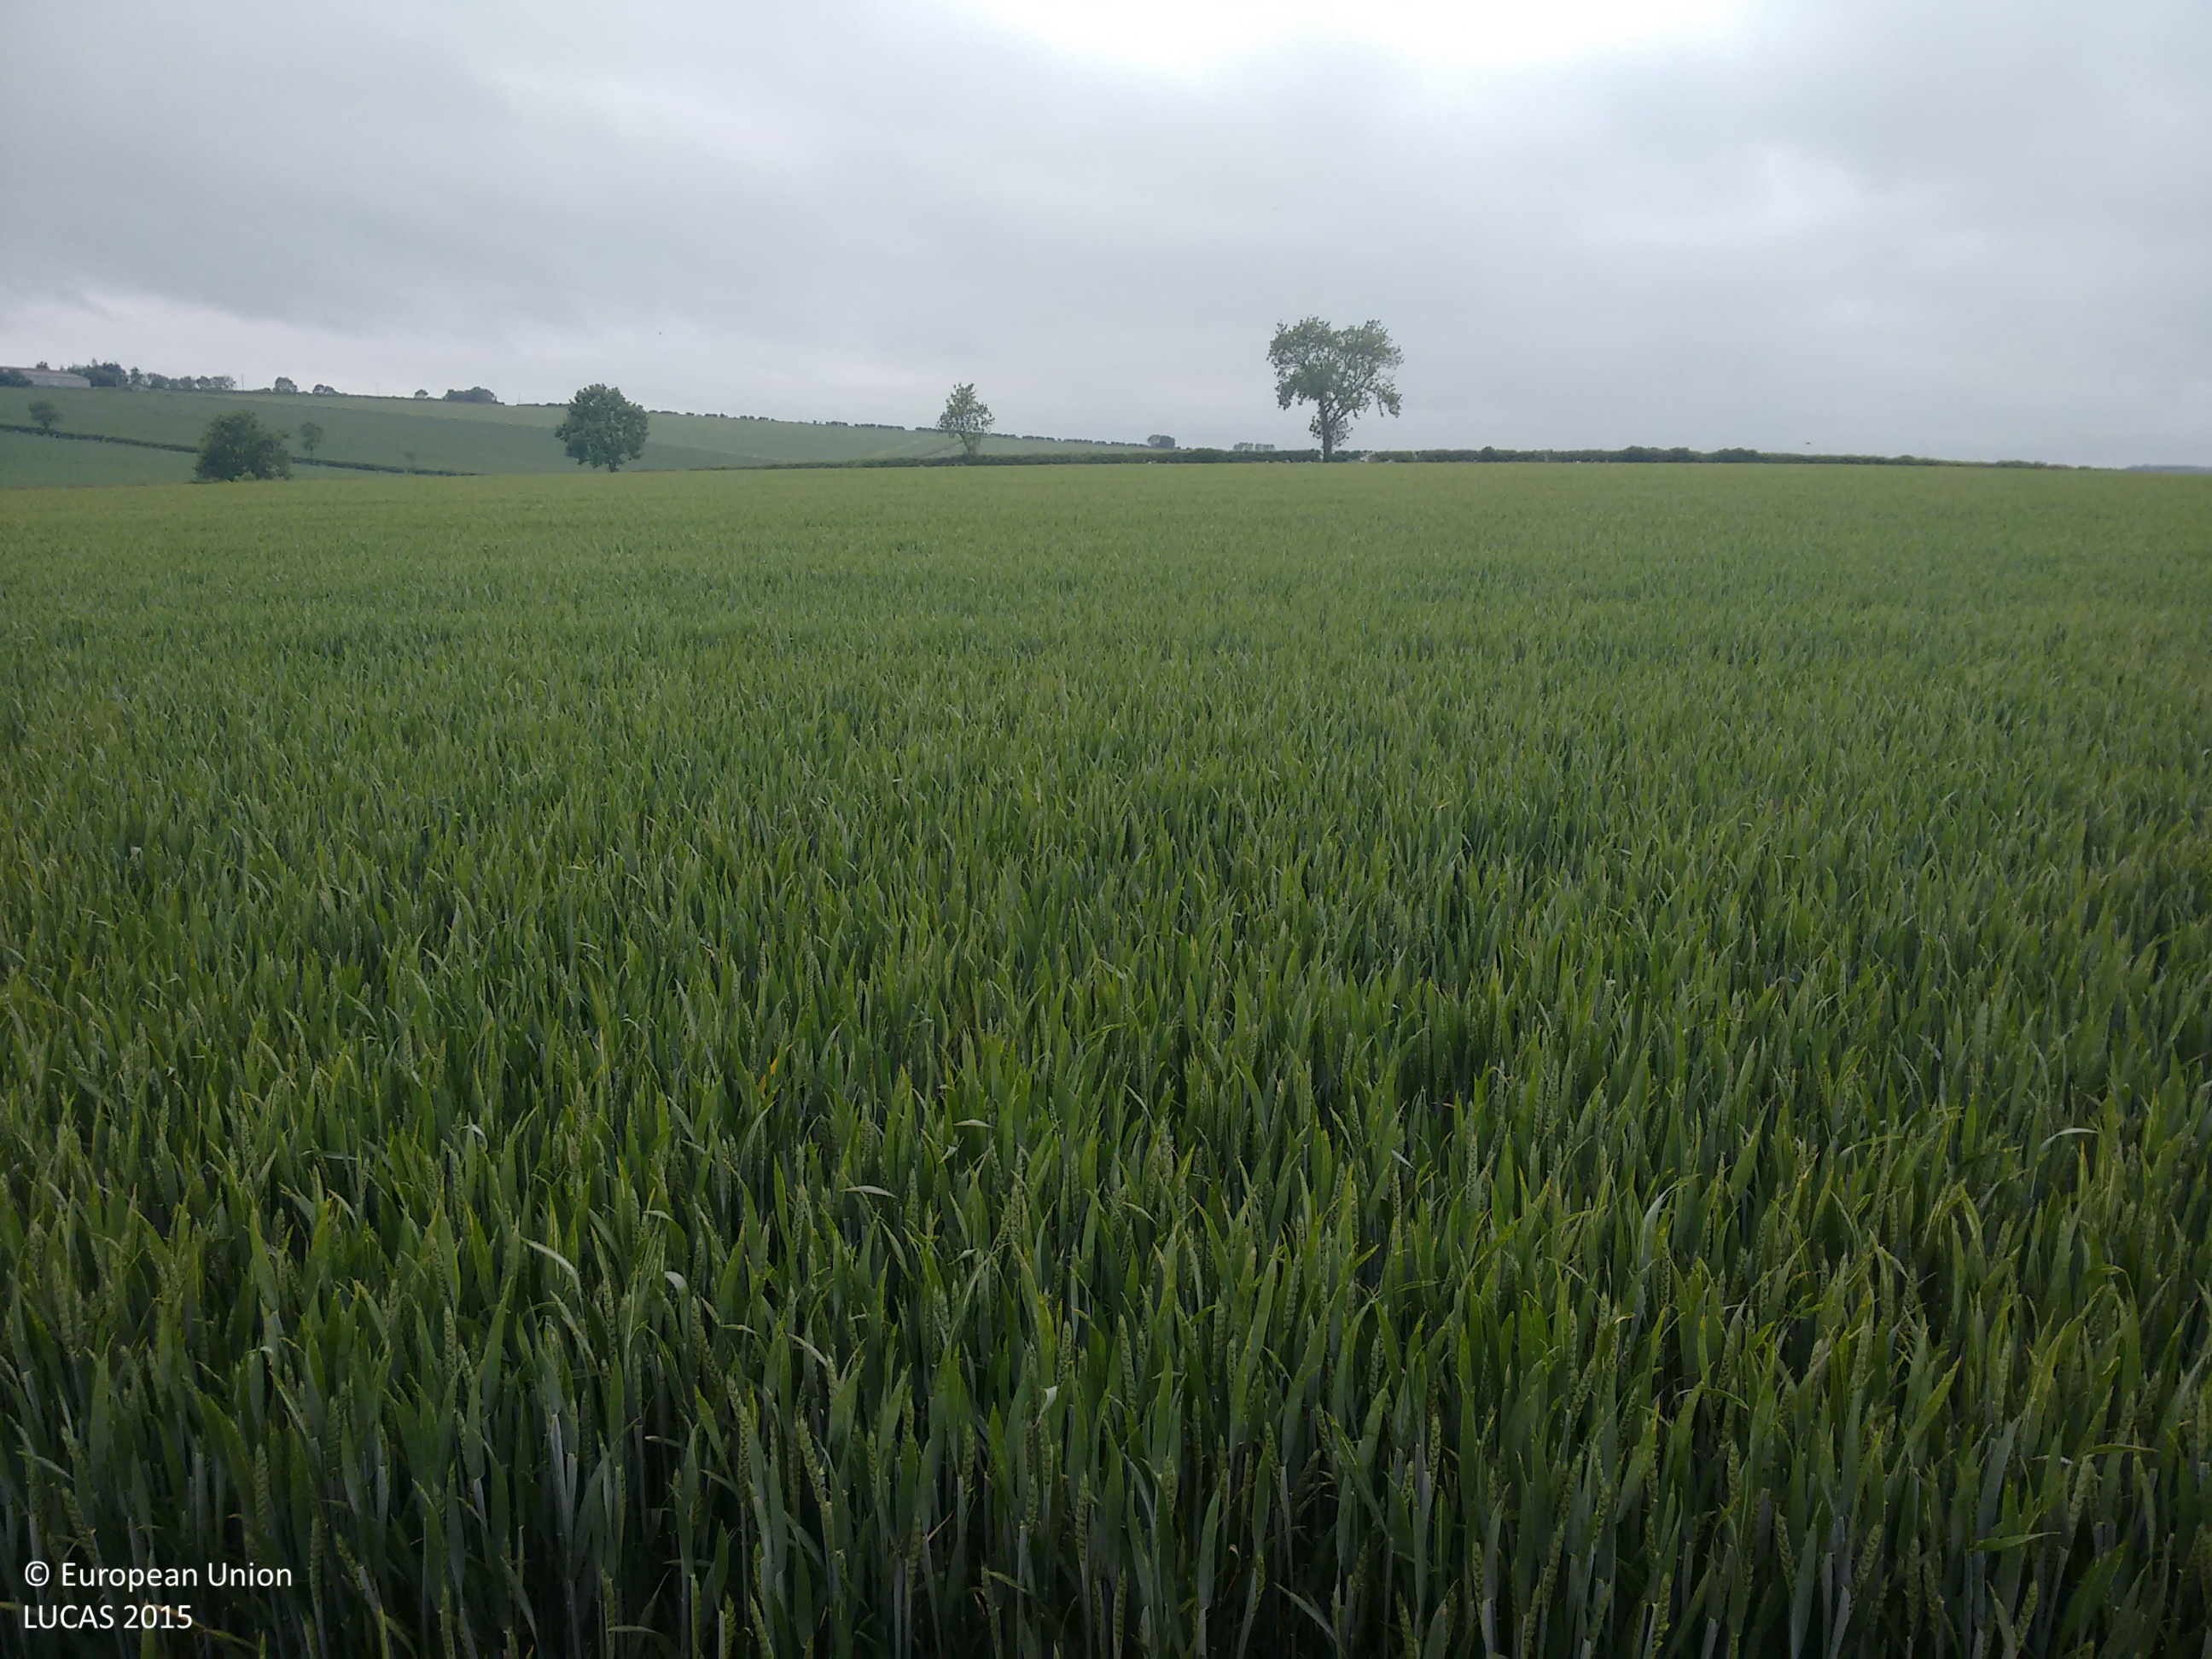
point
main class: Cropland
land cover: Common wheat
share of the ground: > 75 %
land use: Agriculture (excluding fallow land and kitchen gardens)
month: June
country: GB
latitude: 54.1216
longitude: -0.5172
